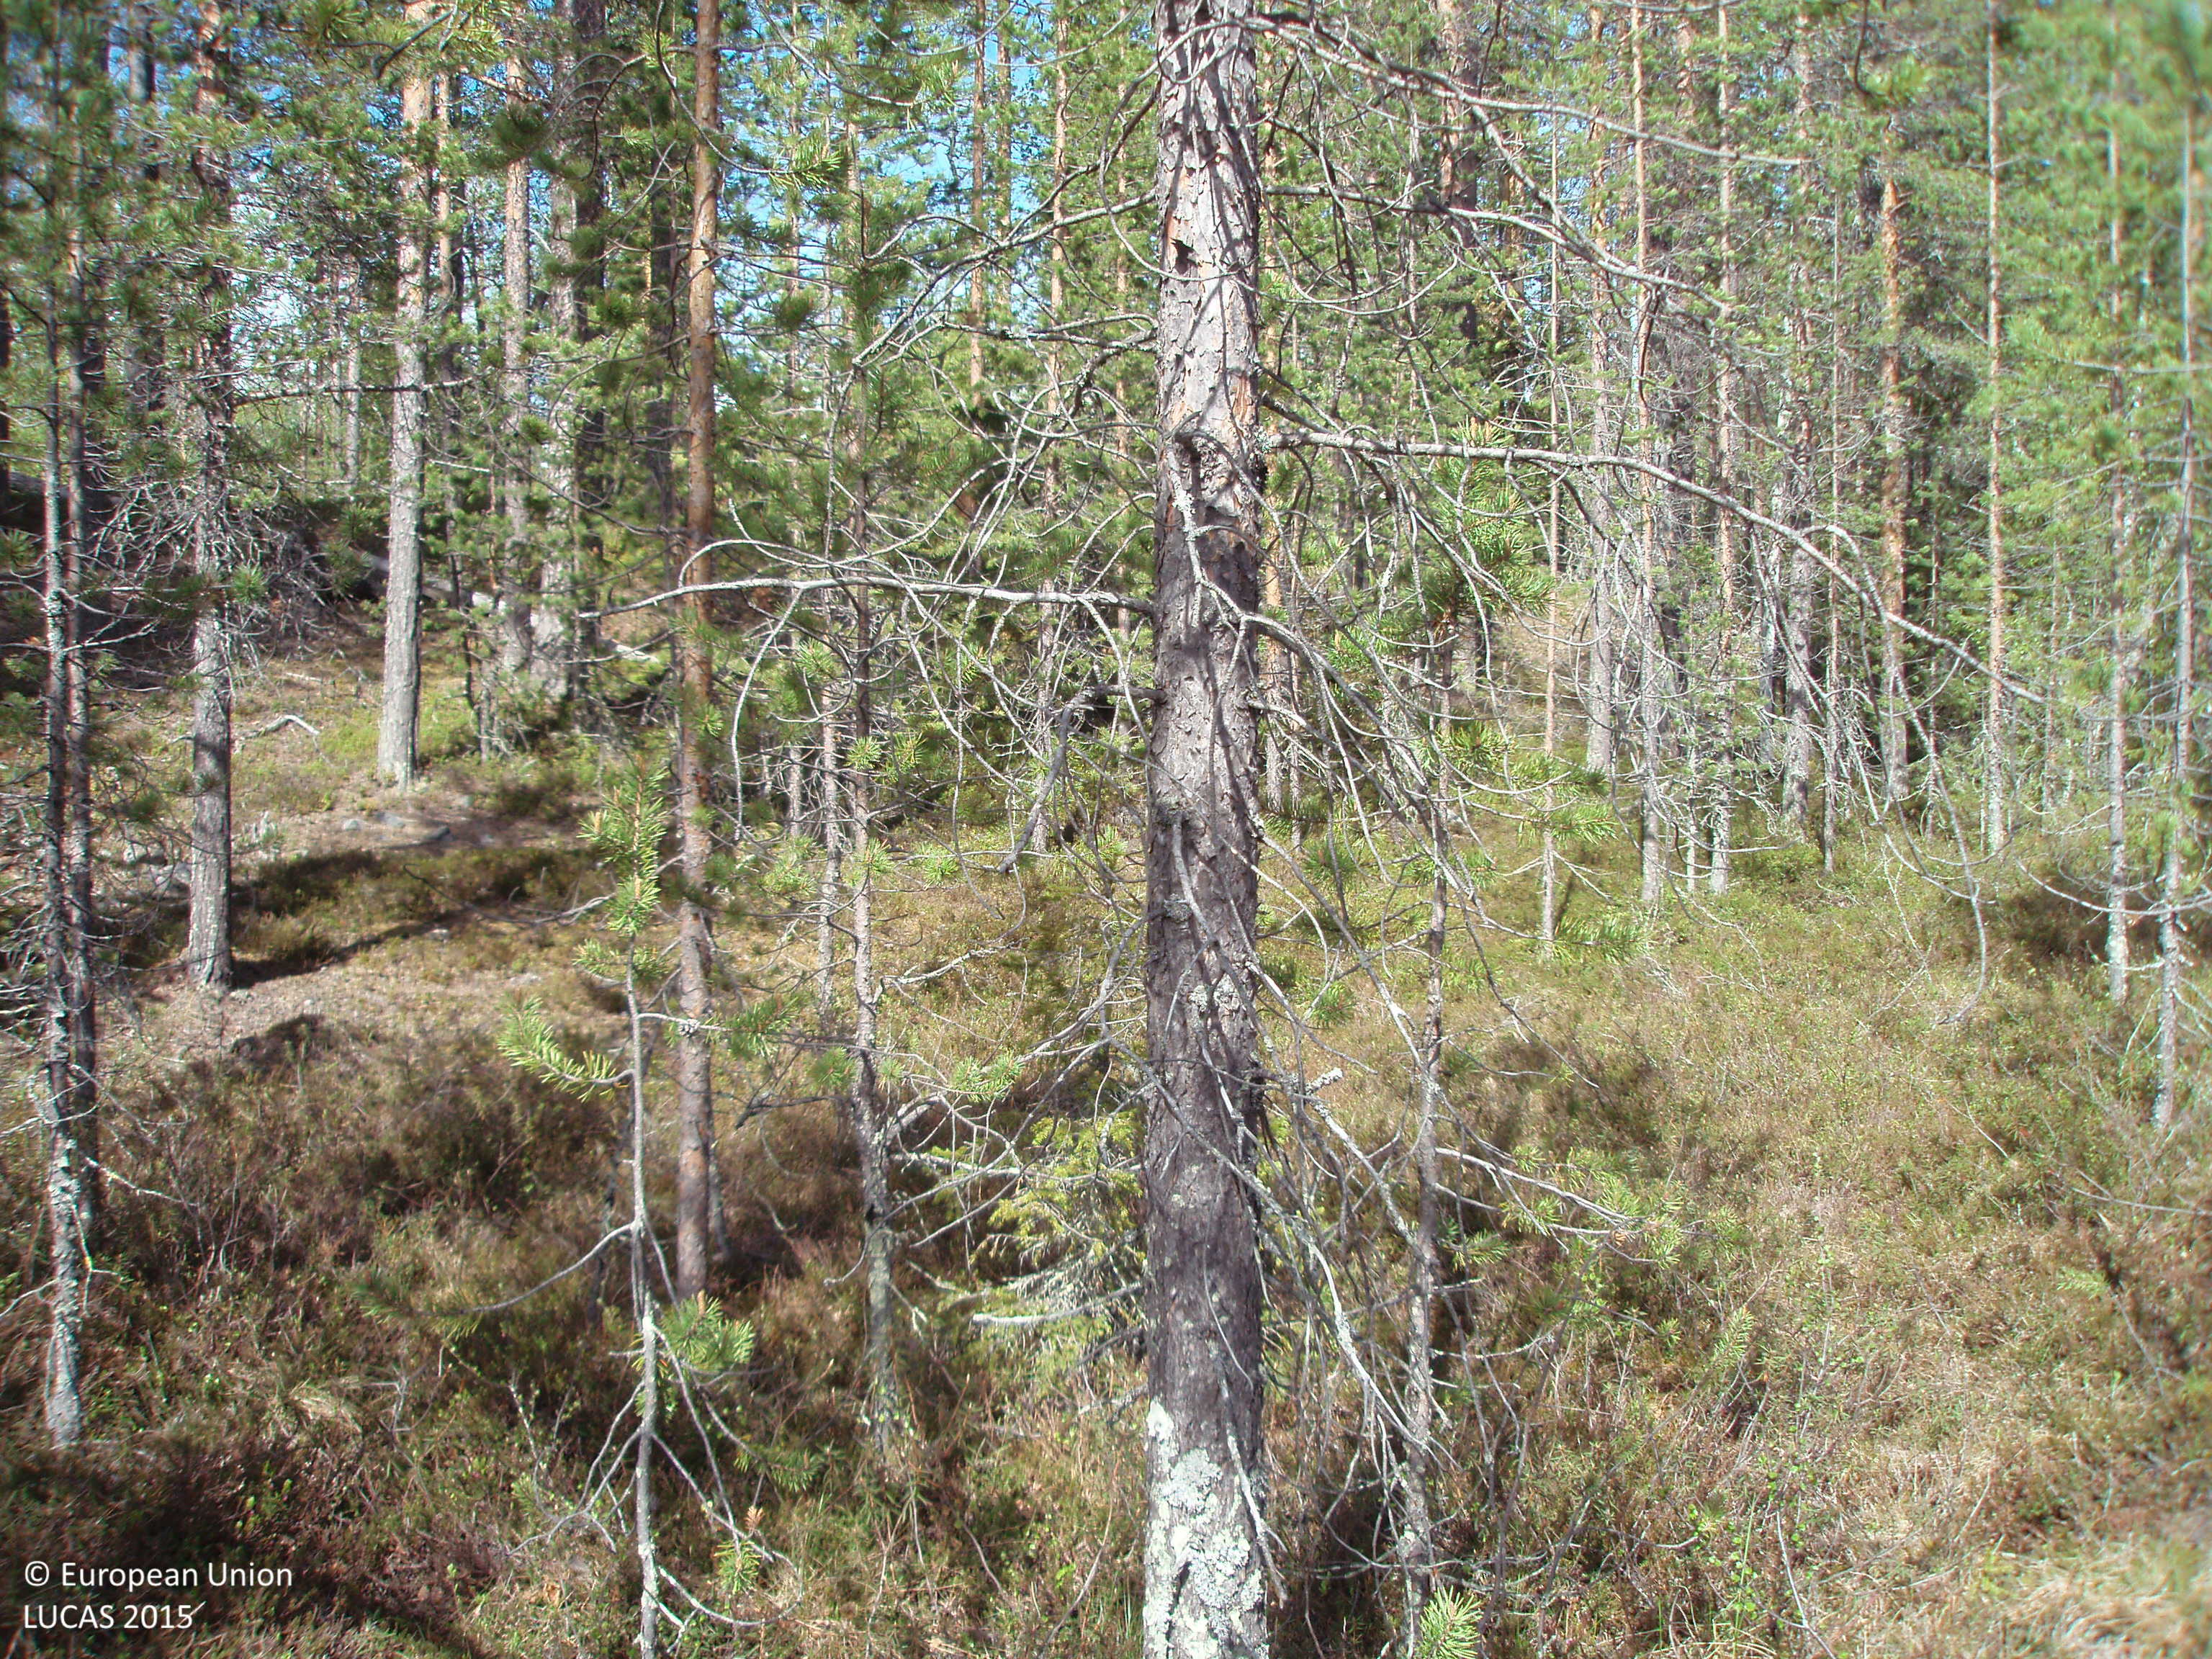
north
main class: Woodland
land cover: Pine dominated coniferous woodland
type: boreal forest
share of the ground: 50 - 75 %
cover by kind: coniferous forest trees 55 %, shrubs 30 %, broadleaved forest trees 15 %
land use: Forestry
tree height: > 5 m
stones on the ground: < 10 %
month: June
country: FI
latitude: 67.0760
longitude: 27.0480
